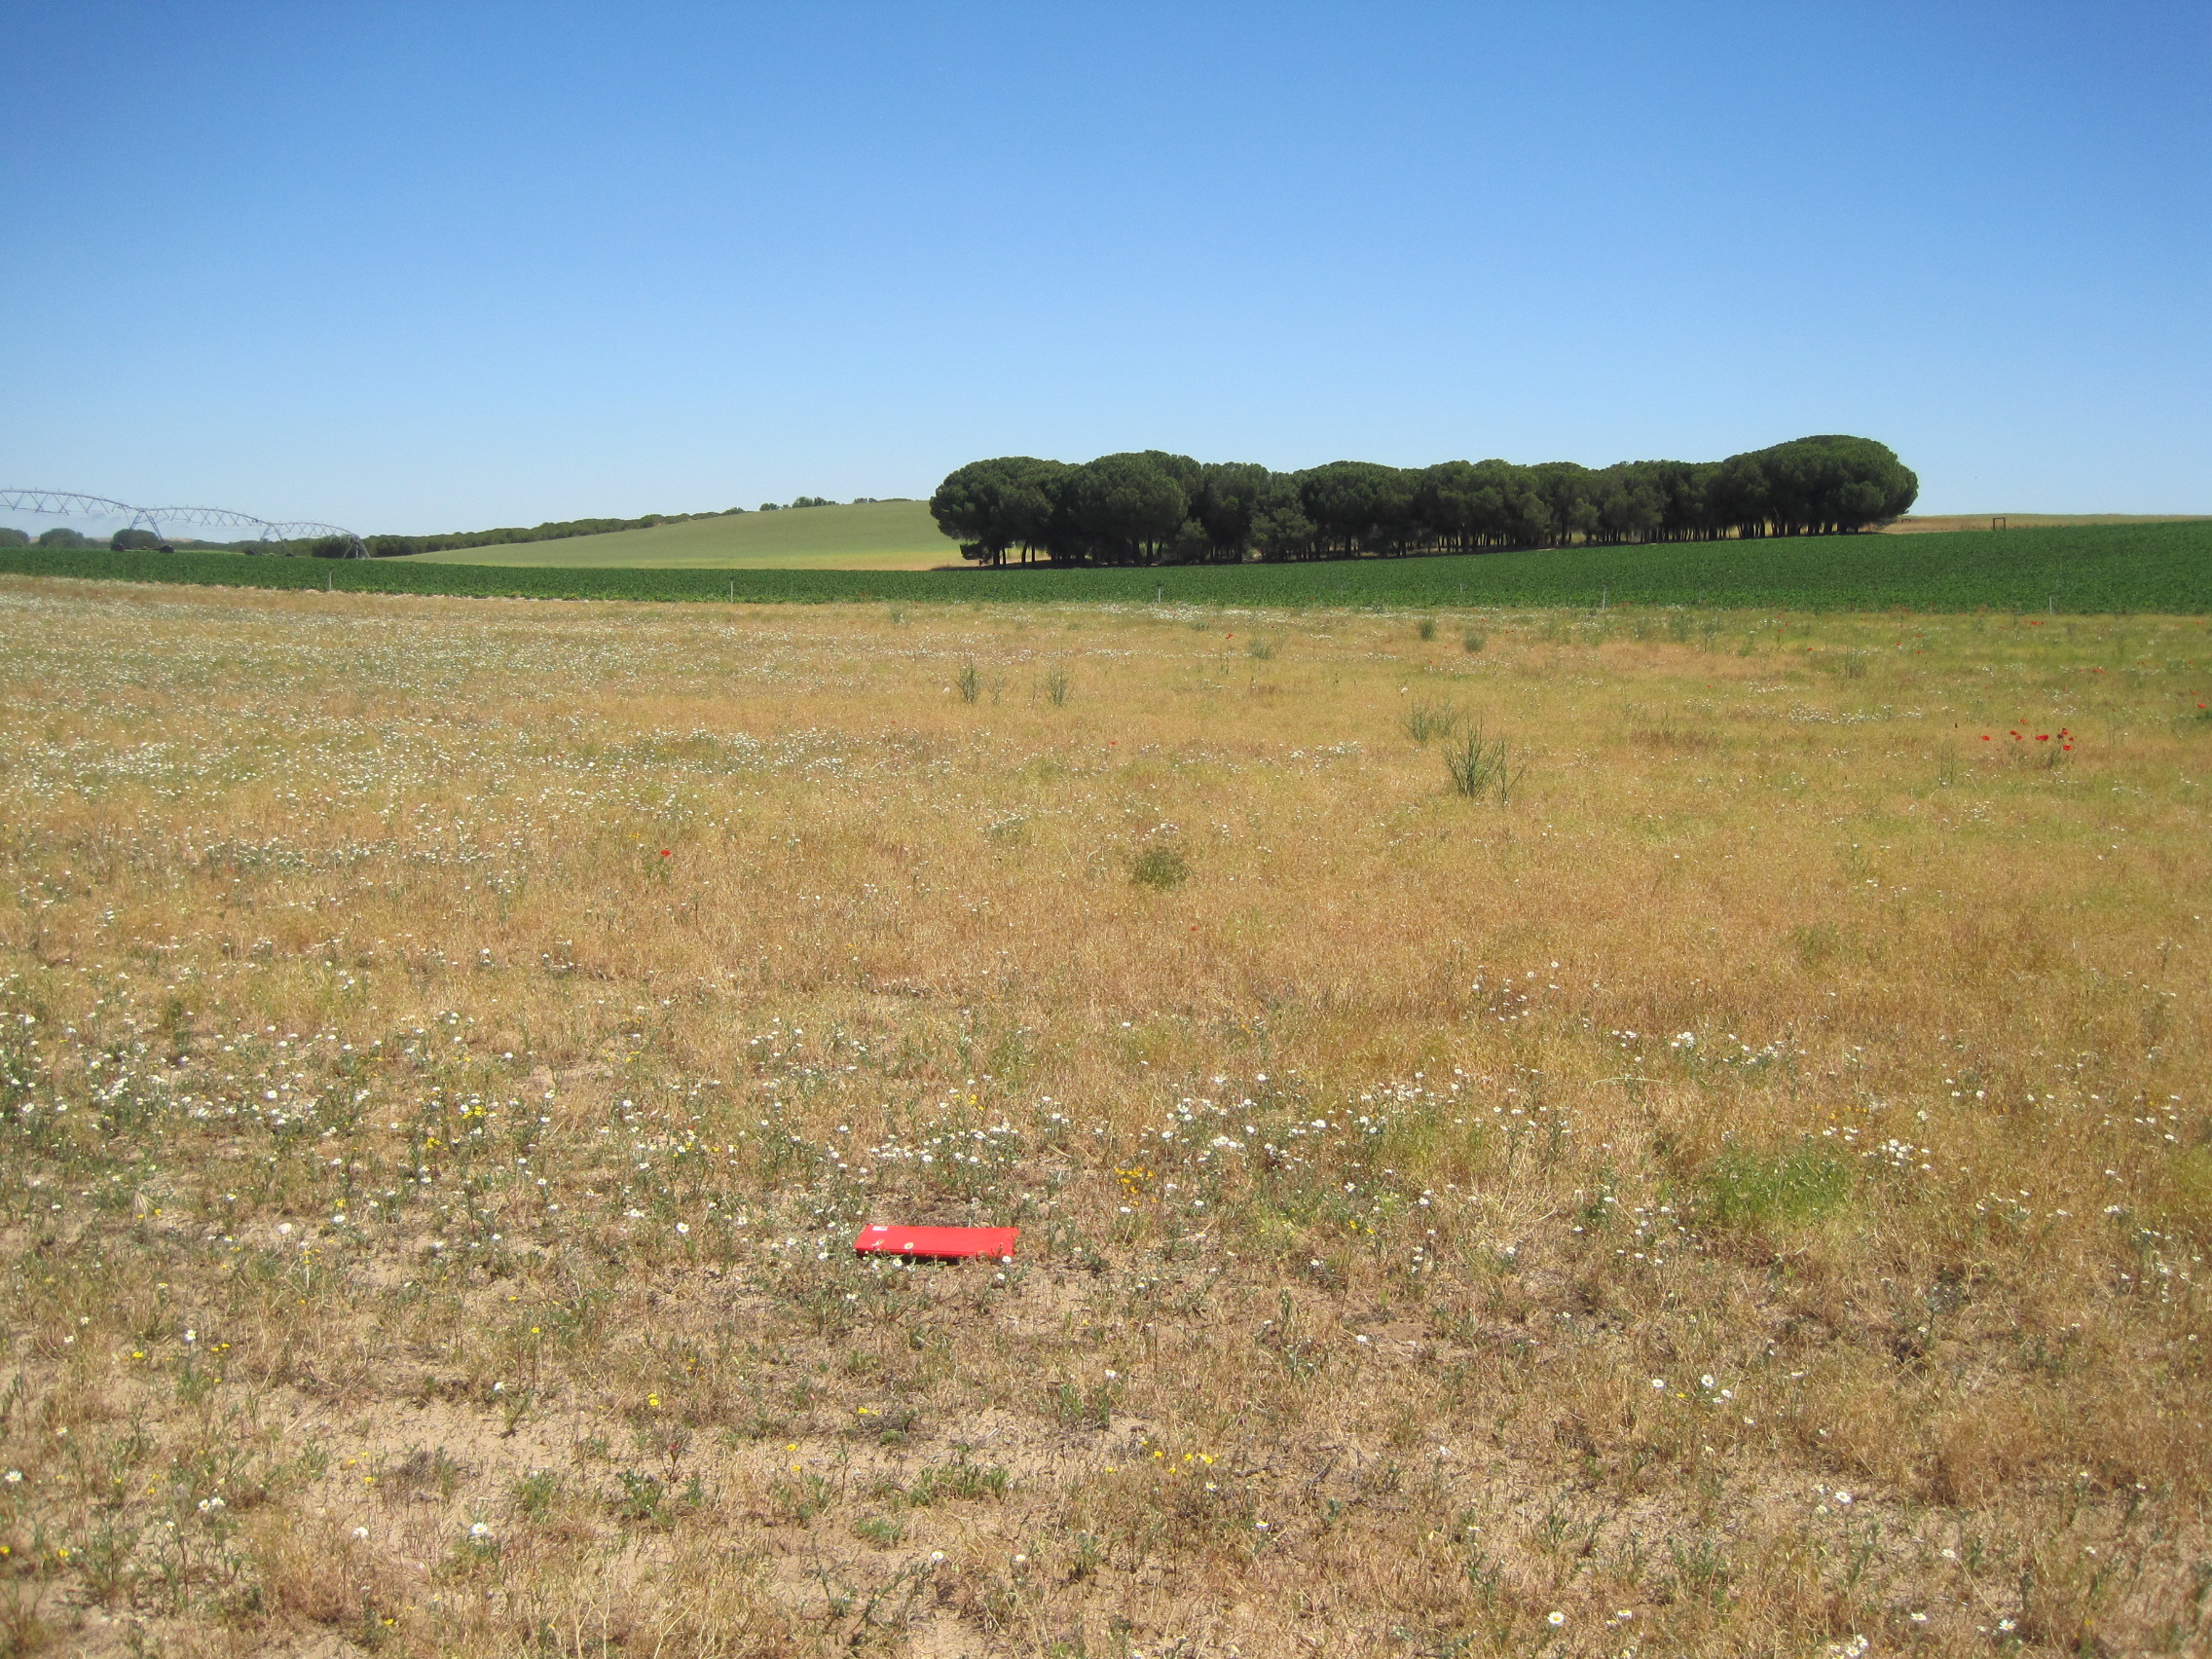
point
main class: Cropland
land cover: Dry pulses
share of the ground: > 75 %
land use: Agriculture (excluding fallow land and kitchen gardens)
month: May
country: ES
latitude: 41.2894
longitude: -5.2507
